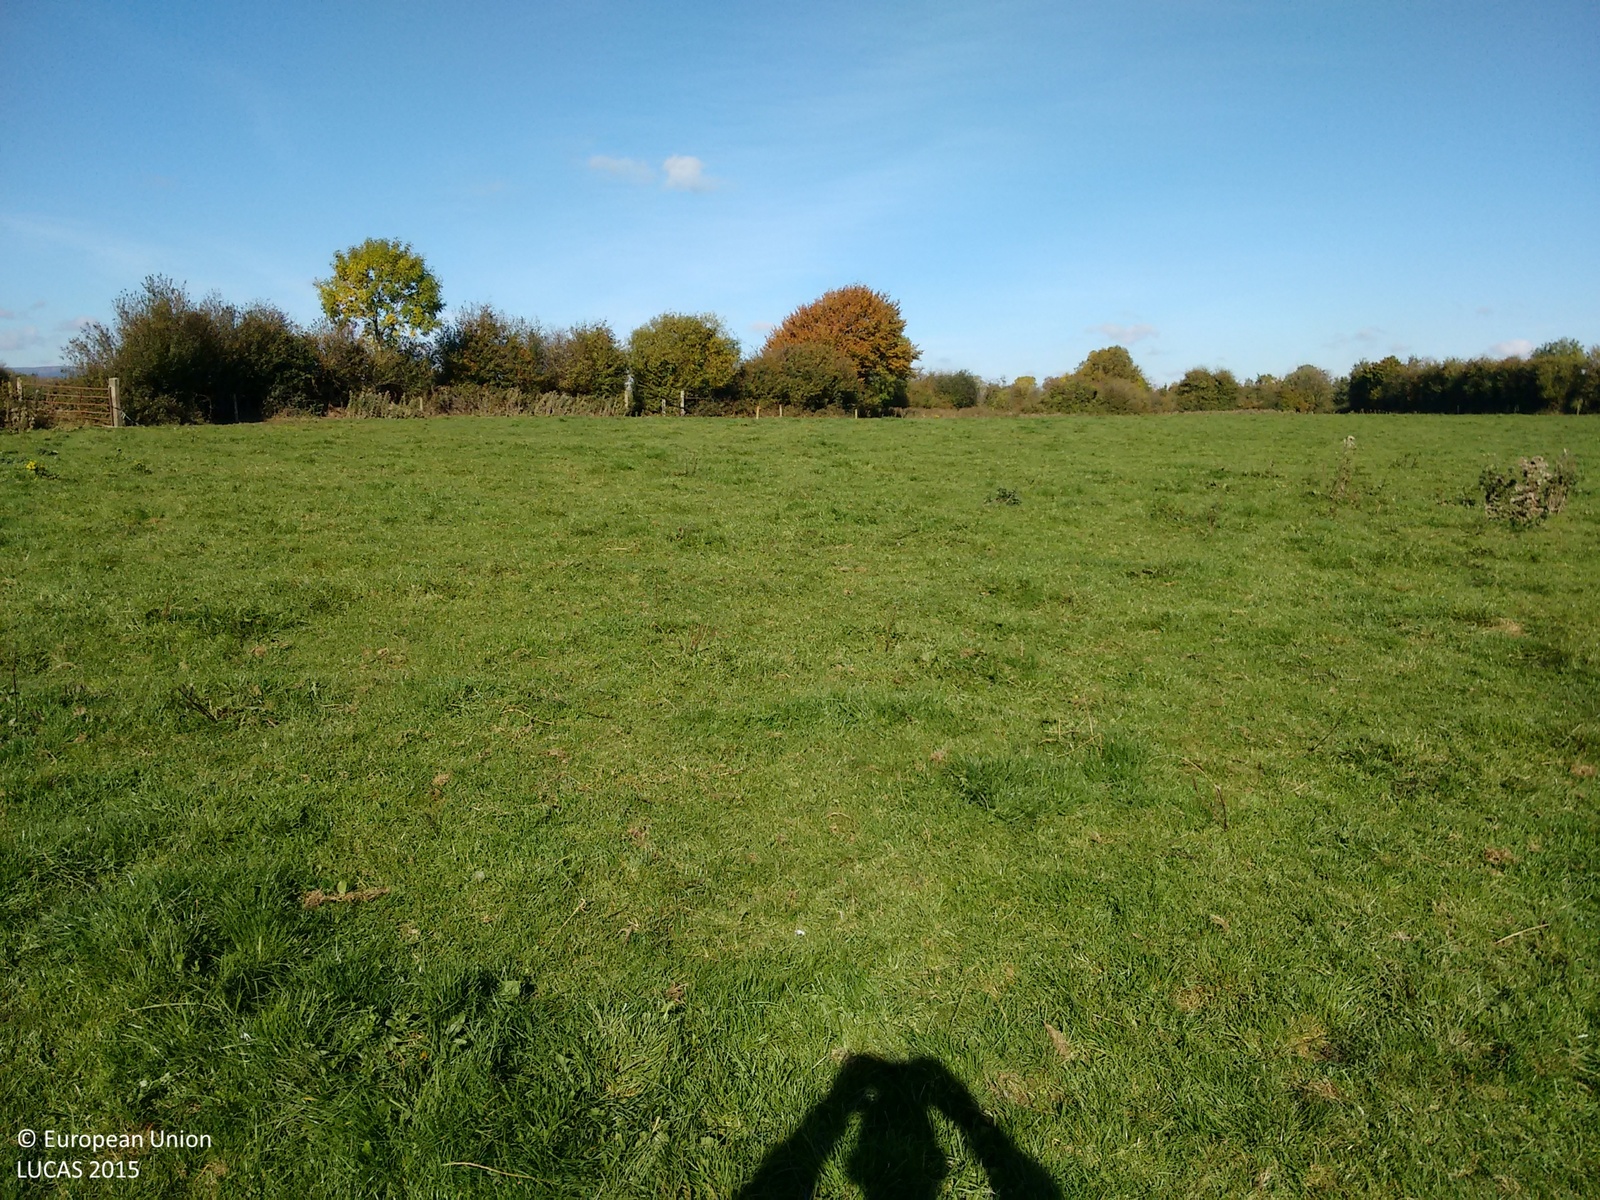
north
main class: Grassland
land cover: Grassland without tree/shrub cover
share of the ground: > 75 %
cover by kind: herbaceous plants 100 %
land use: Agriculture (excluding fallow land and kitchen gardens)
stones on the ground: < 10 %
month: October
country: IE
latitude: 52.9729
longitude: -7.4148
